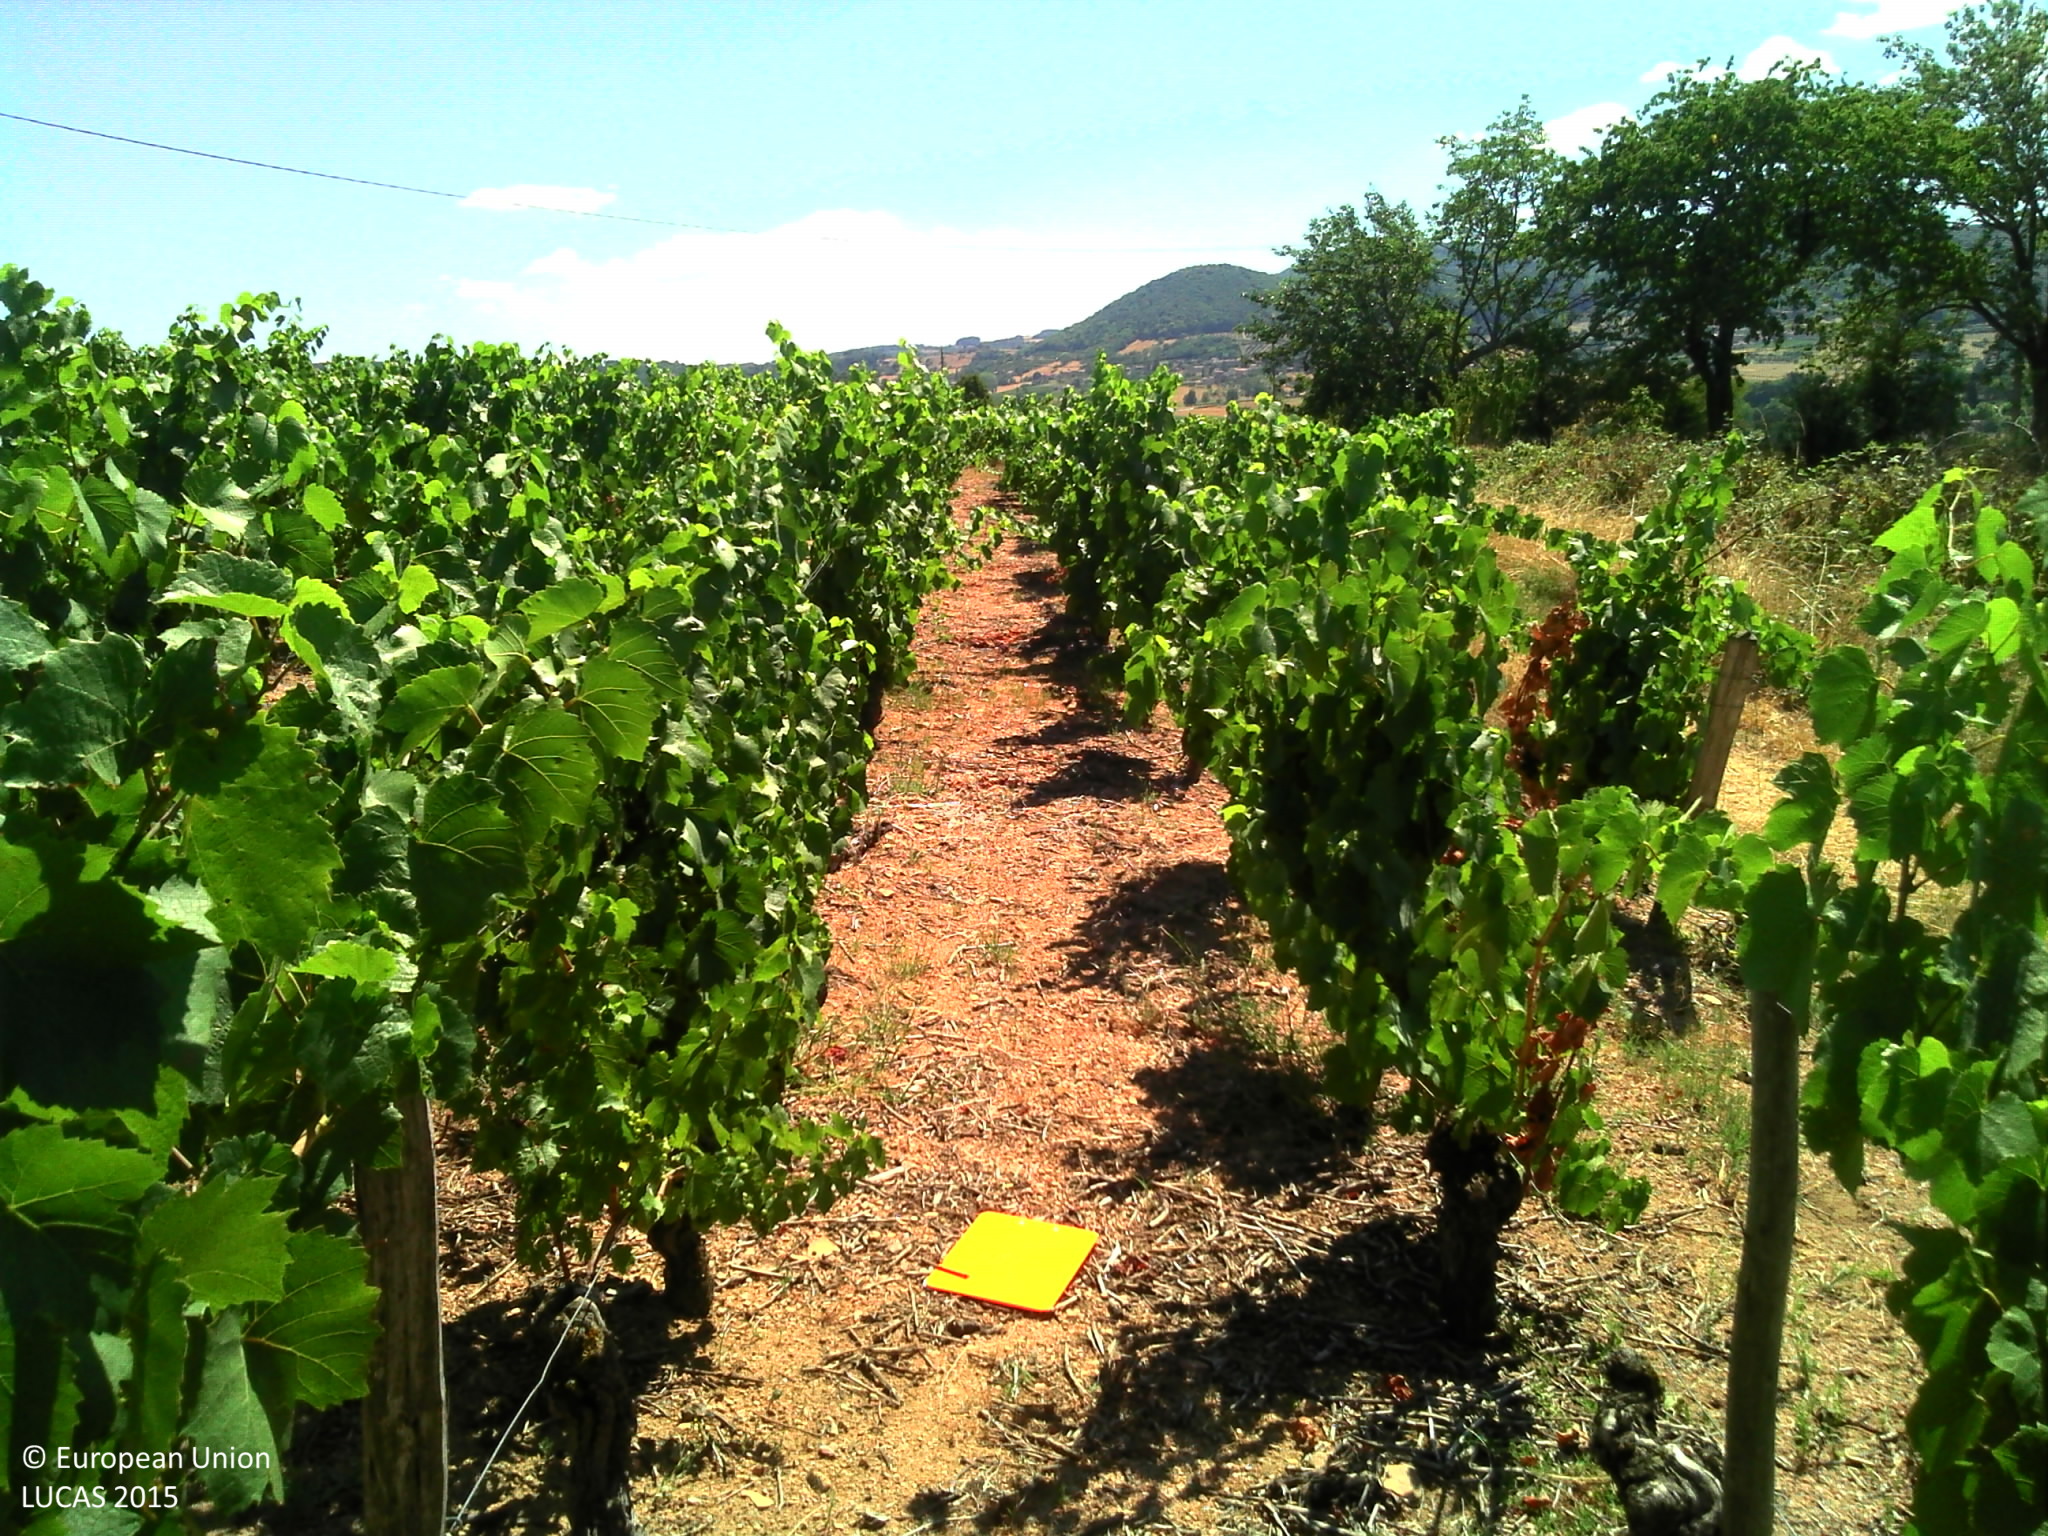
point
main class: Cropland
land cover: Vineyards
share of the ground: 50 - 75 %
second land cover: Other bare soil
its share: > 75 %
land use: Agriculture (excluding fallow land and kitchen gardens)
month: July
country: FR
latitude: 45.8695
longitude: 4.5538
